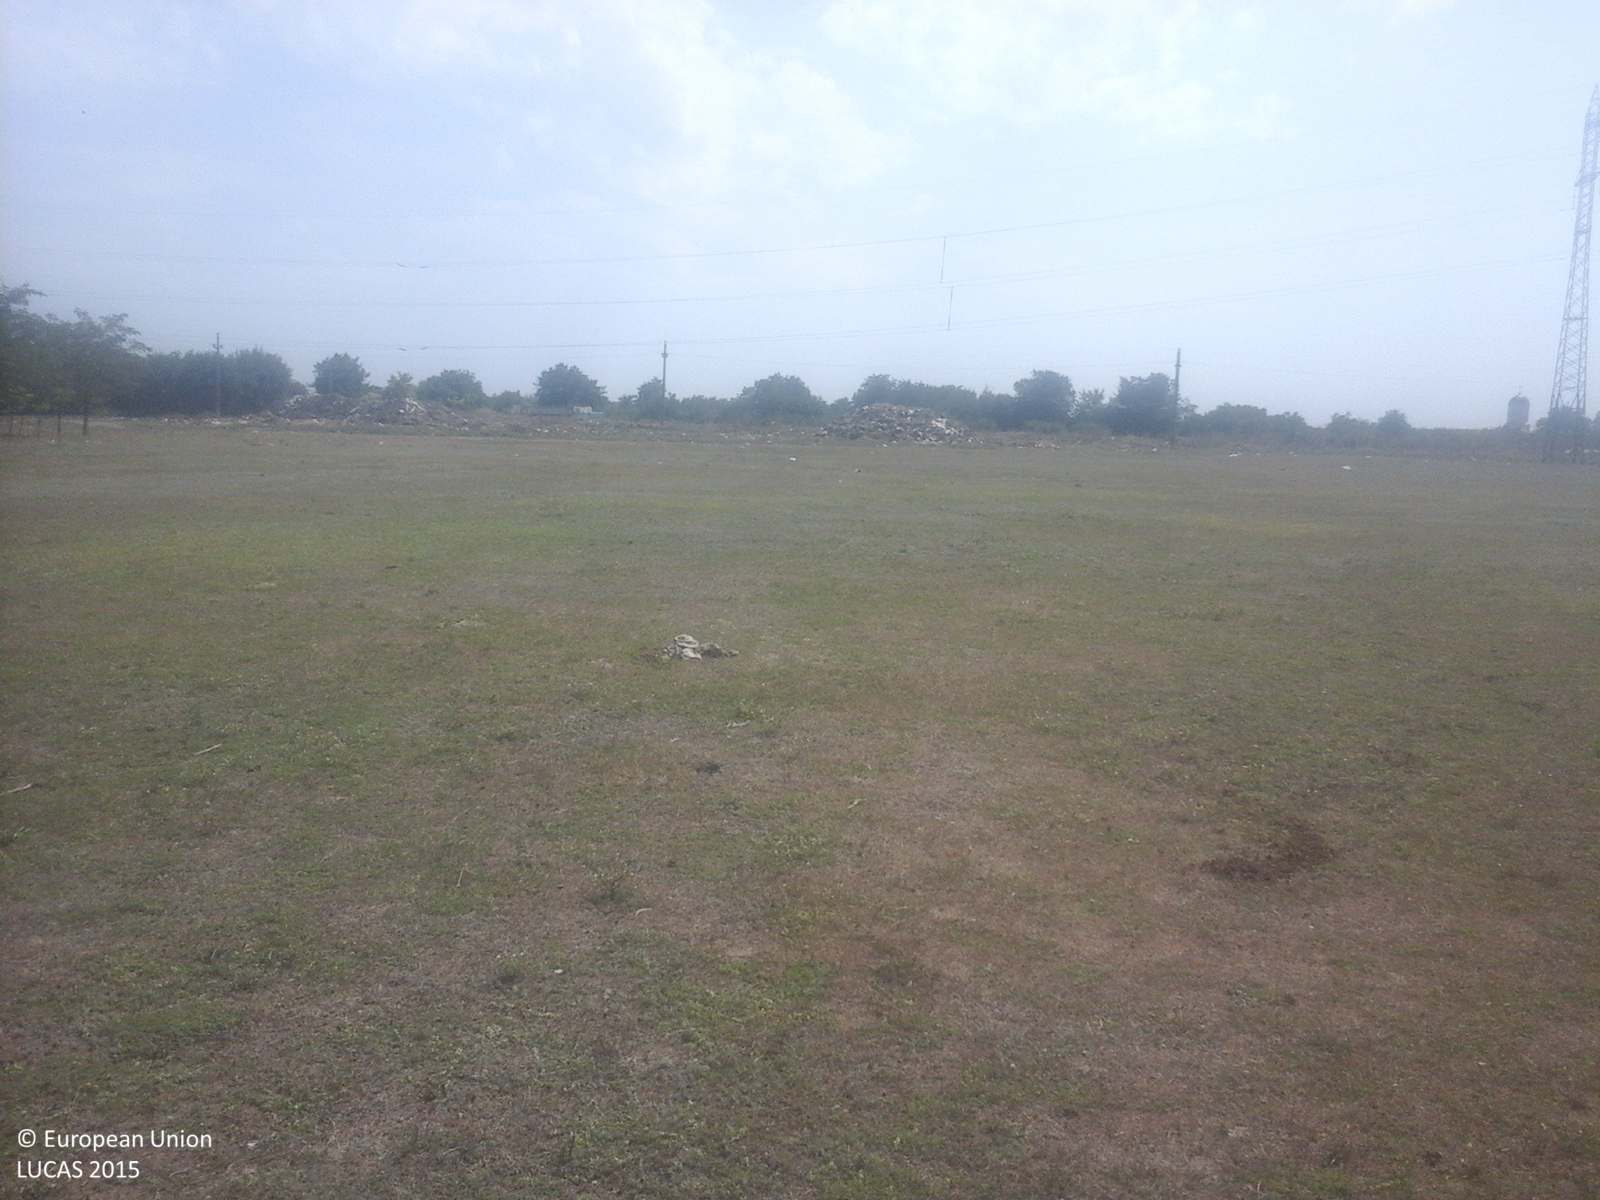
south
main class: Grassland
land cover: Grassland without tree/shrub cover
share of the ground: > 75 %
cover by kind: herbaceous plants 100 %
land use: Agriculture (excluding fallow land and kitchen gardens)
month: August
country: RO
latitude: 44.1104
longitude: 28.2912
